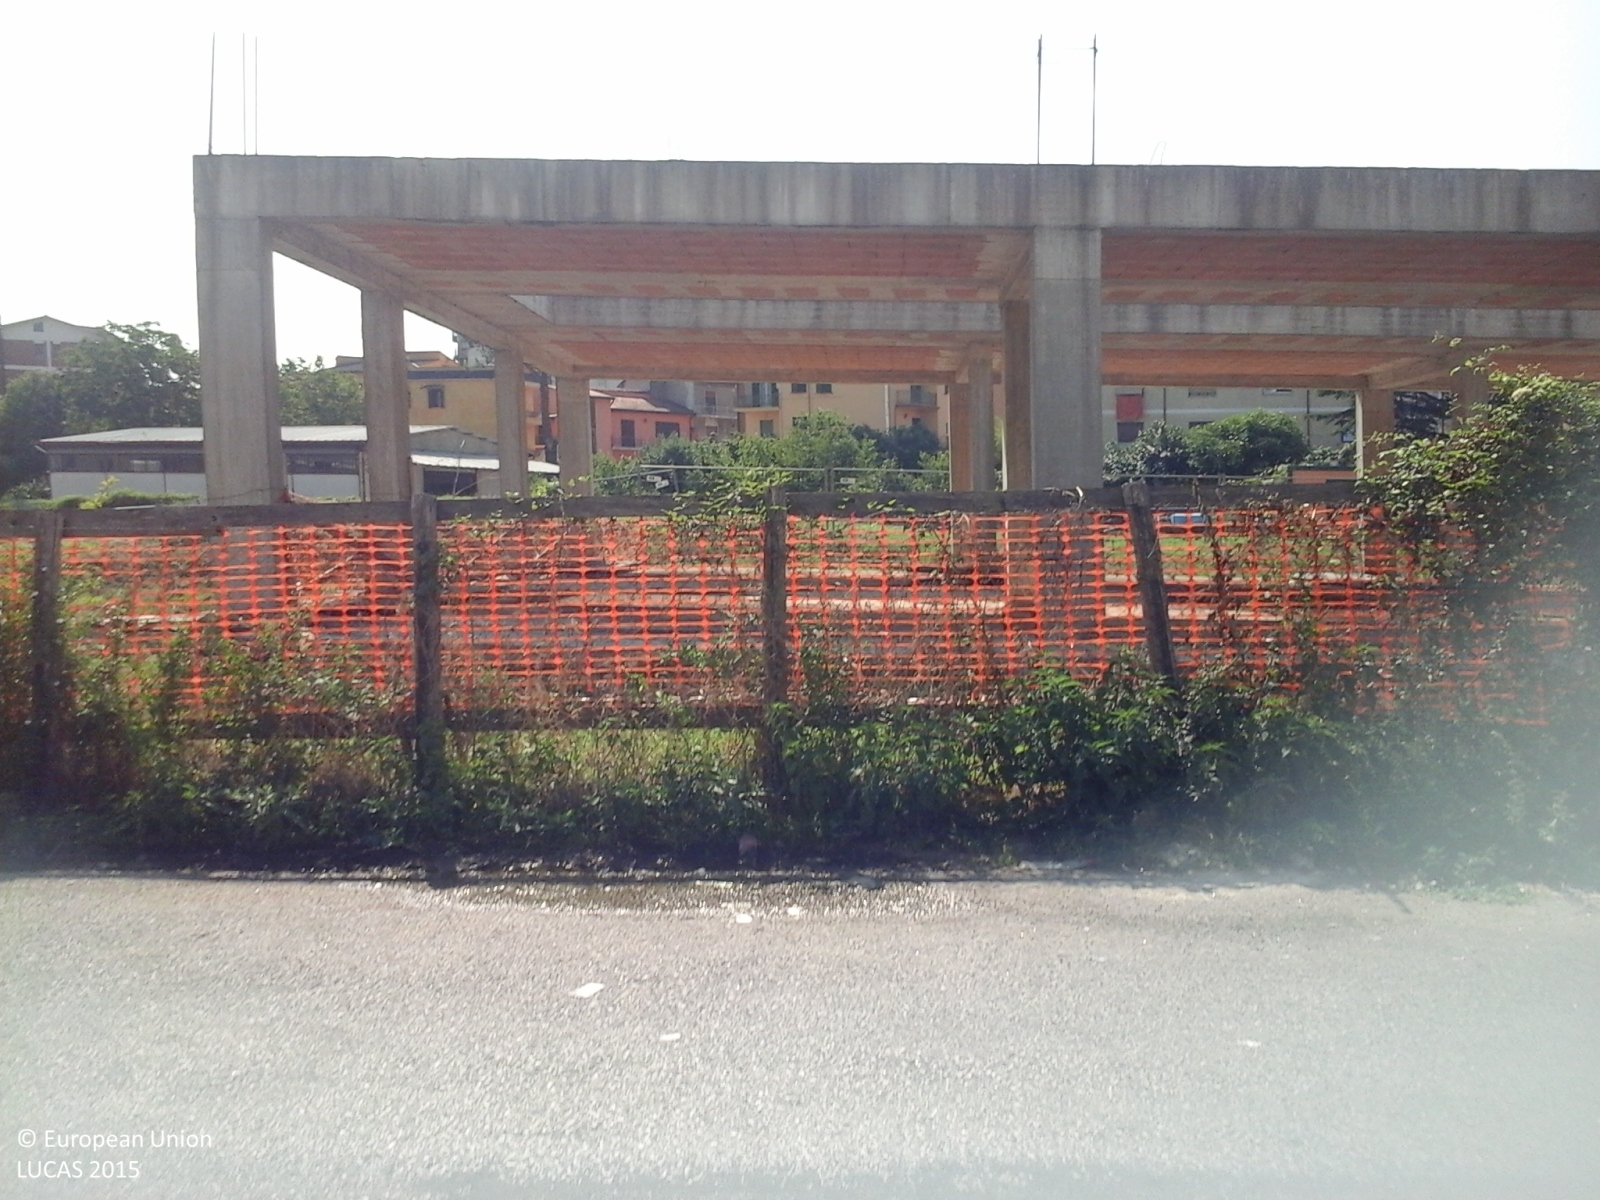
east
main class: Grassland
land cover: Grassland without tree/shrub cover
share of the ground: 10 - 25 %
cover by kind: herbaceous plants 100 %
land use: Residential
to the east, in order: Grassland without tree/shrub cover; Artificial constructions in urban areas; Other fruit trees and berries; Vineyards; Abandoned hedges; Artificial constructions in urban areas
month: July
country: IT
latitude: 41.7444
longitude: 12.9110
